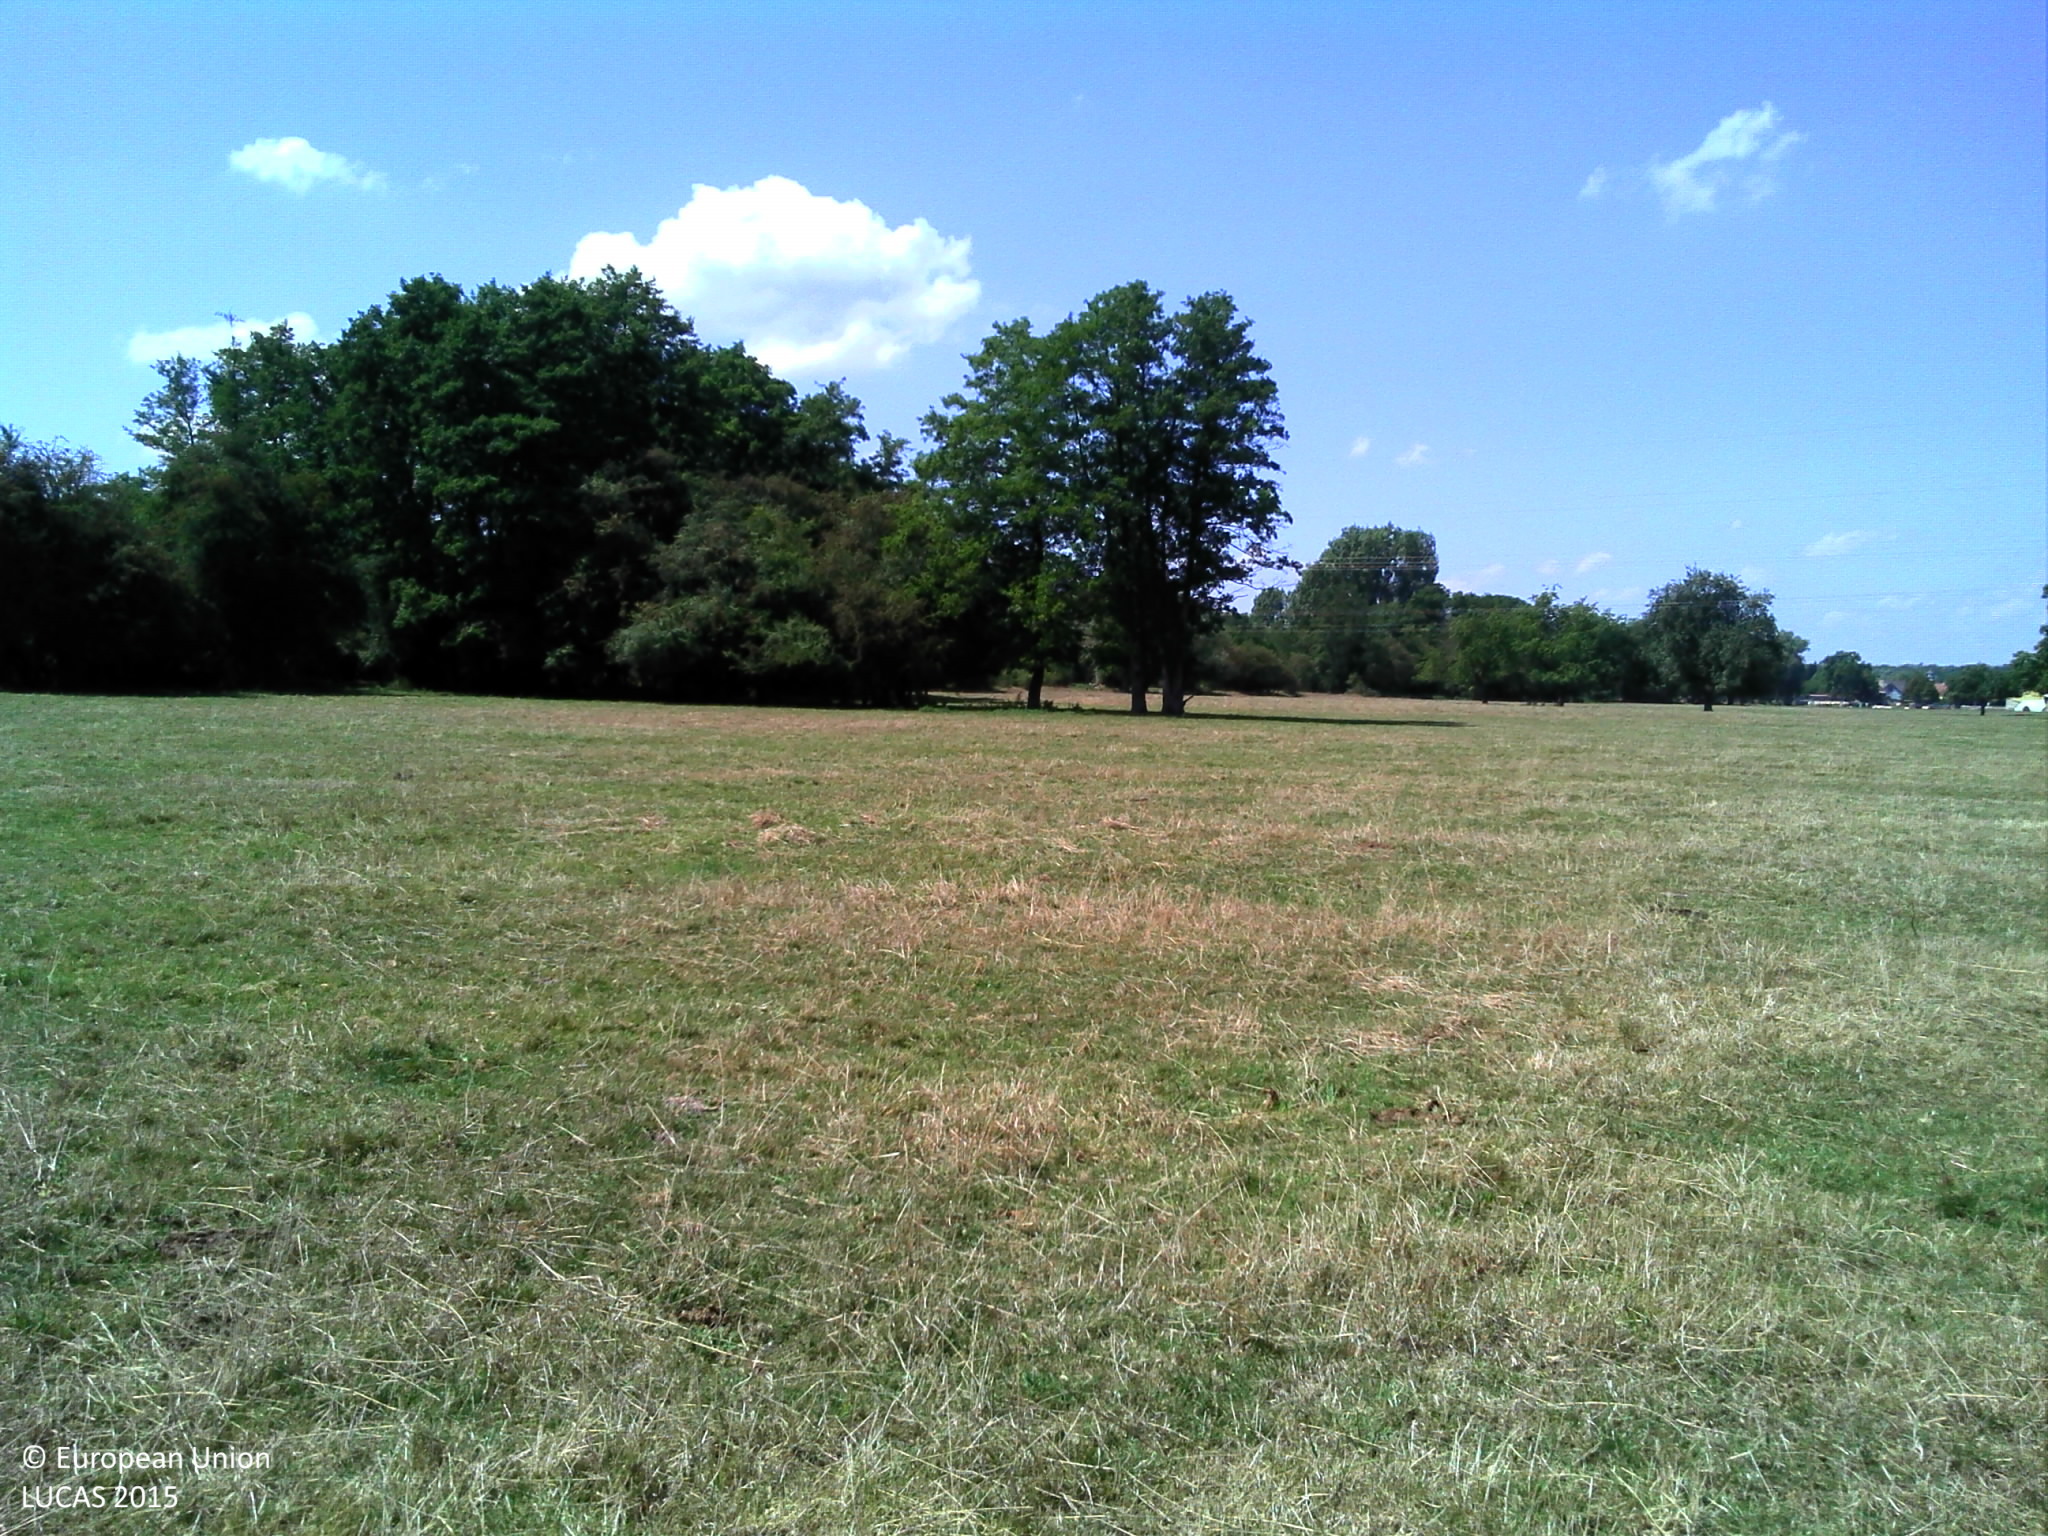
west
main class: Grassland
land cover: Grassland without tree/shrub cover
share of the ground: > 75 %
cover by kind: herbaceous plants 100 %
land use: Agriculture (excluding fallow land and kitchen gardens)
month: August
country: FR
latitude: 48.8543
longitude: 8.0517
